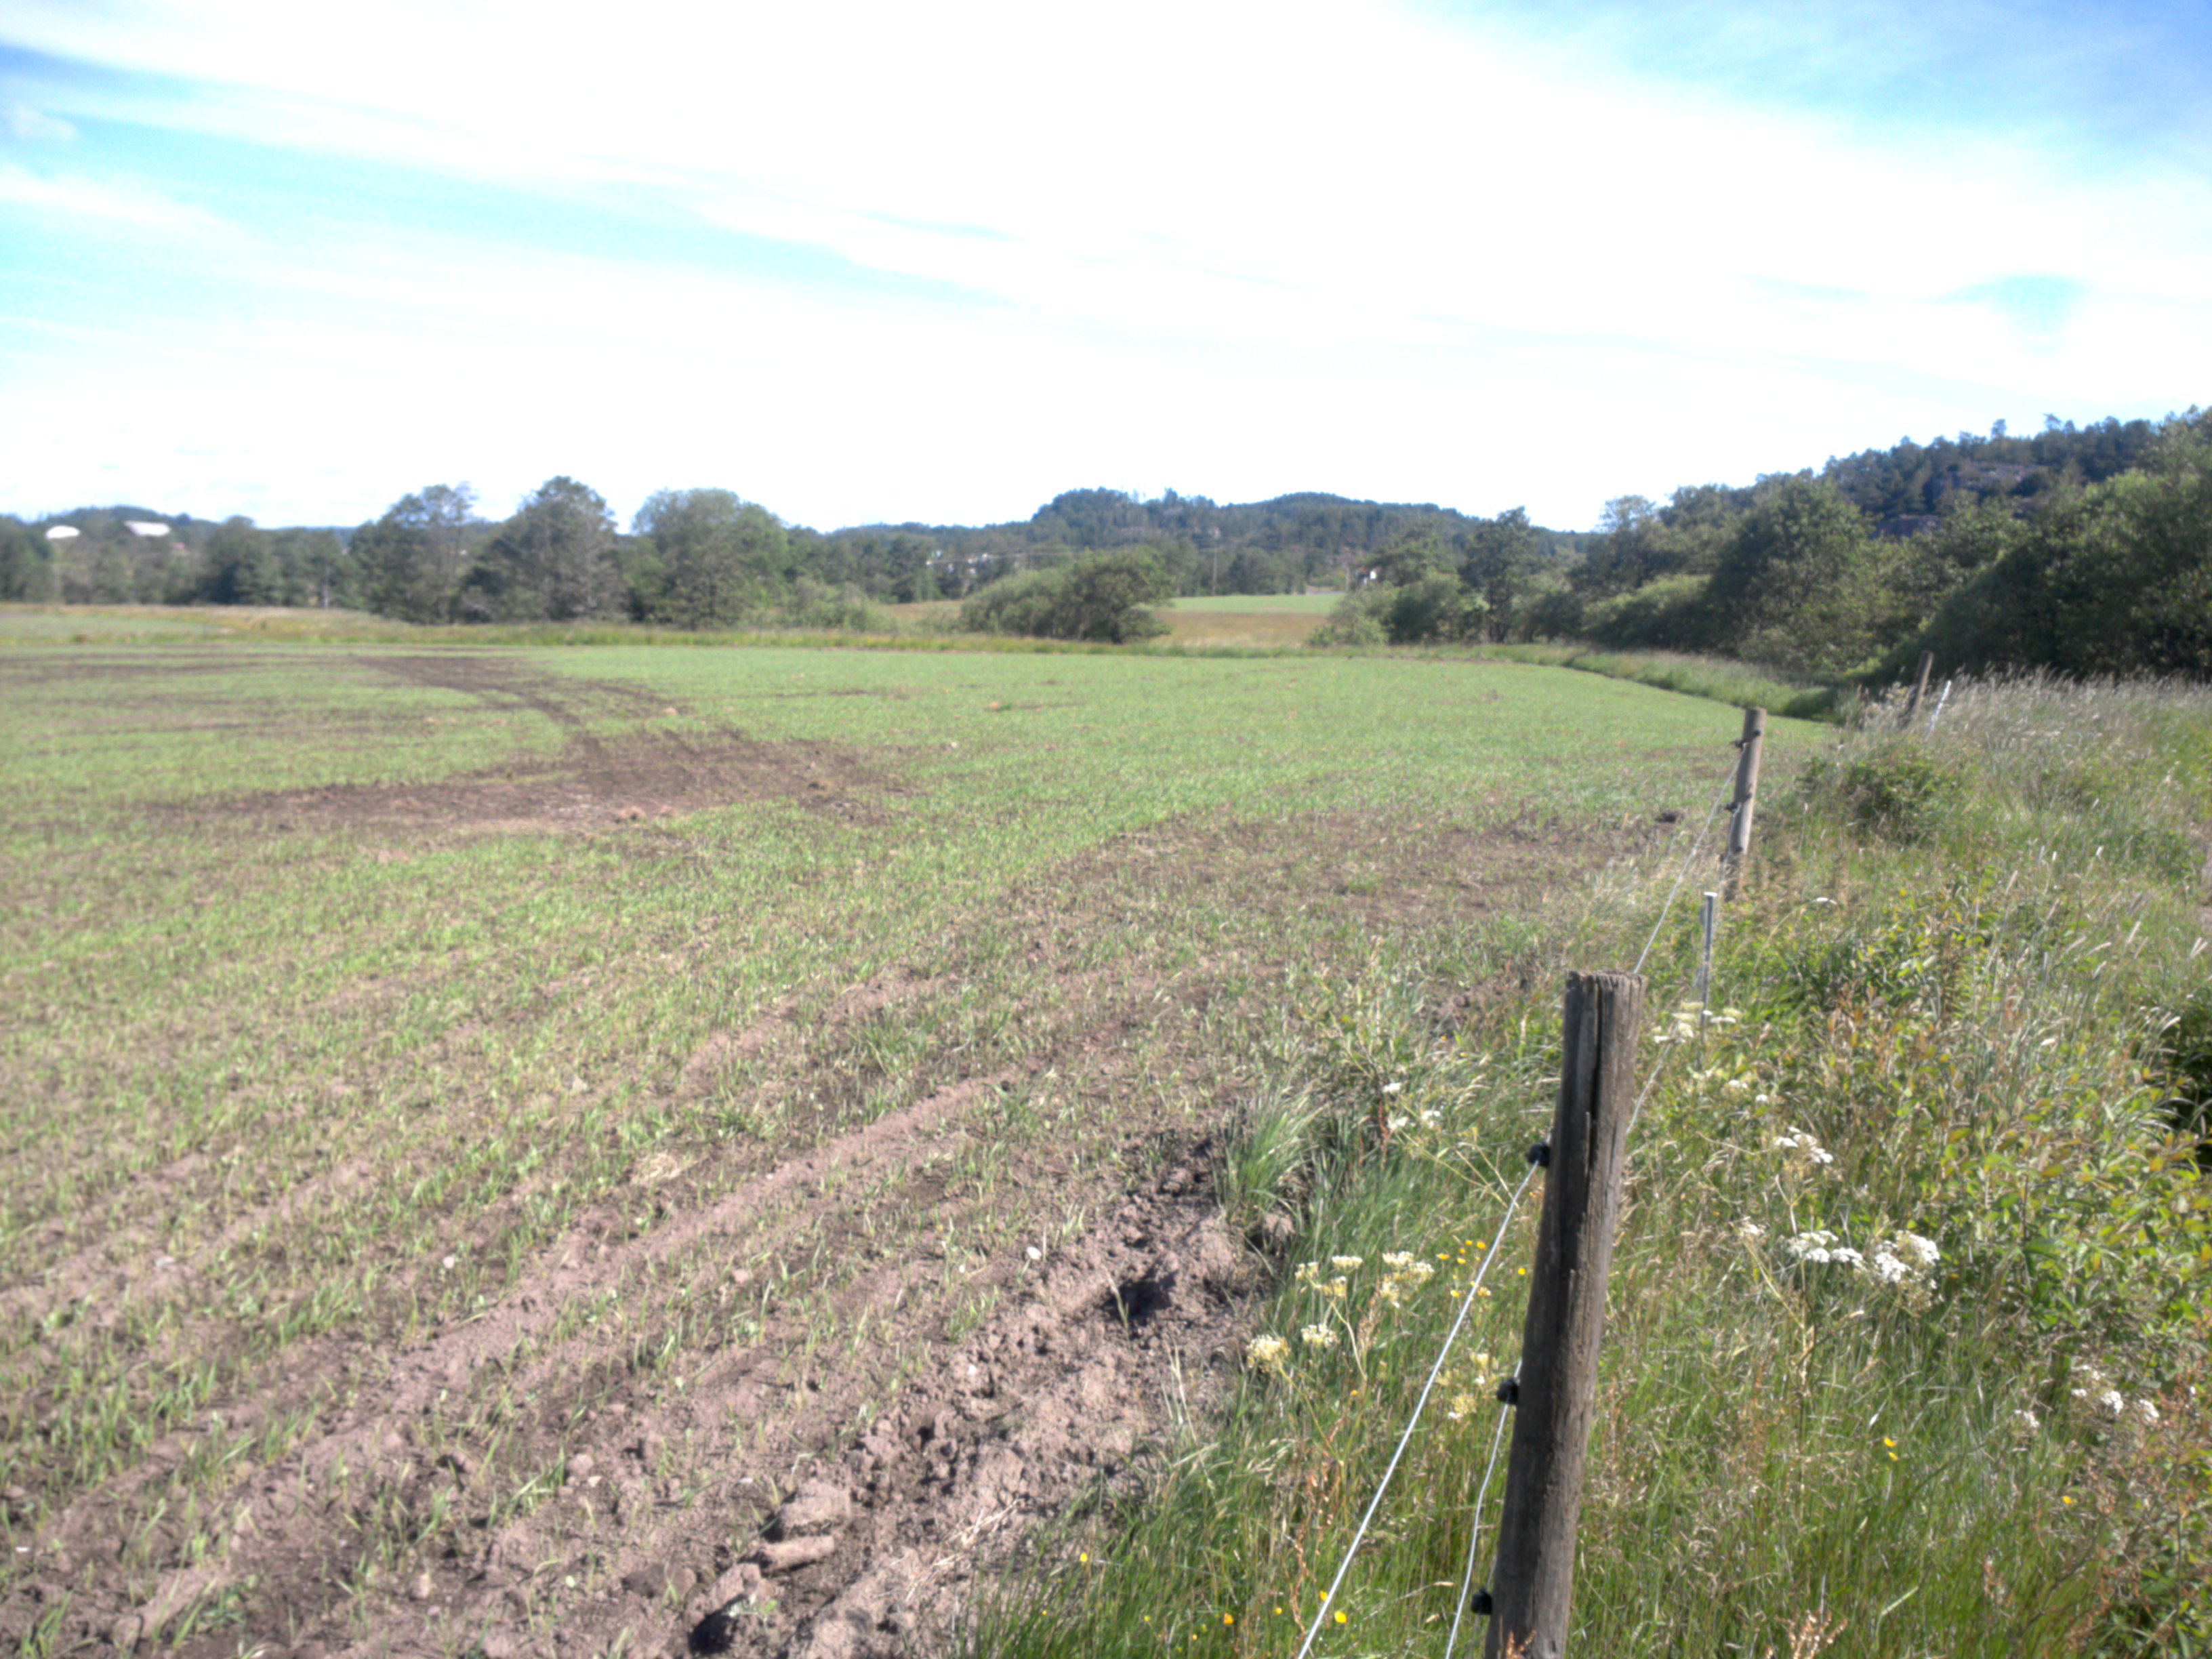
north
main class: Cropland
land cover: Common wheat
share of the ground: 50 - 75 %
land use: Agriculture (excluding fallow land and kitchen gardens)
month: June
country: SE
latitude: 58.4795
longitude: 11.6257
